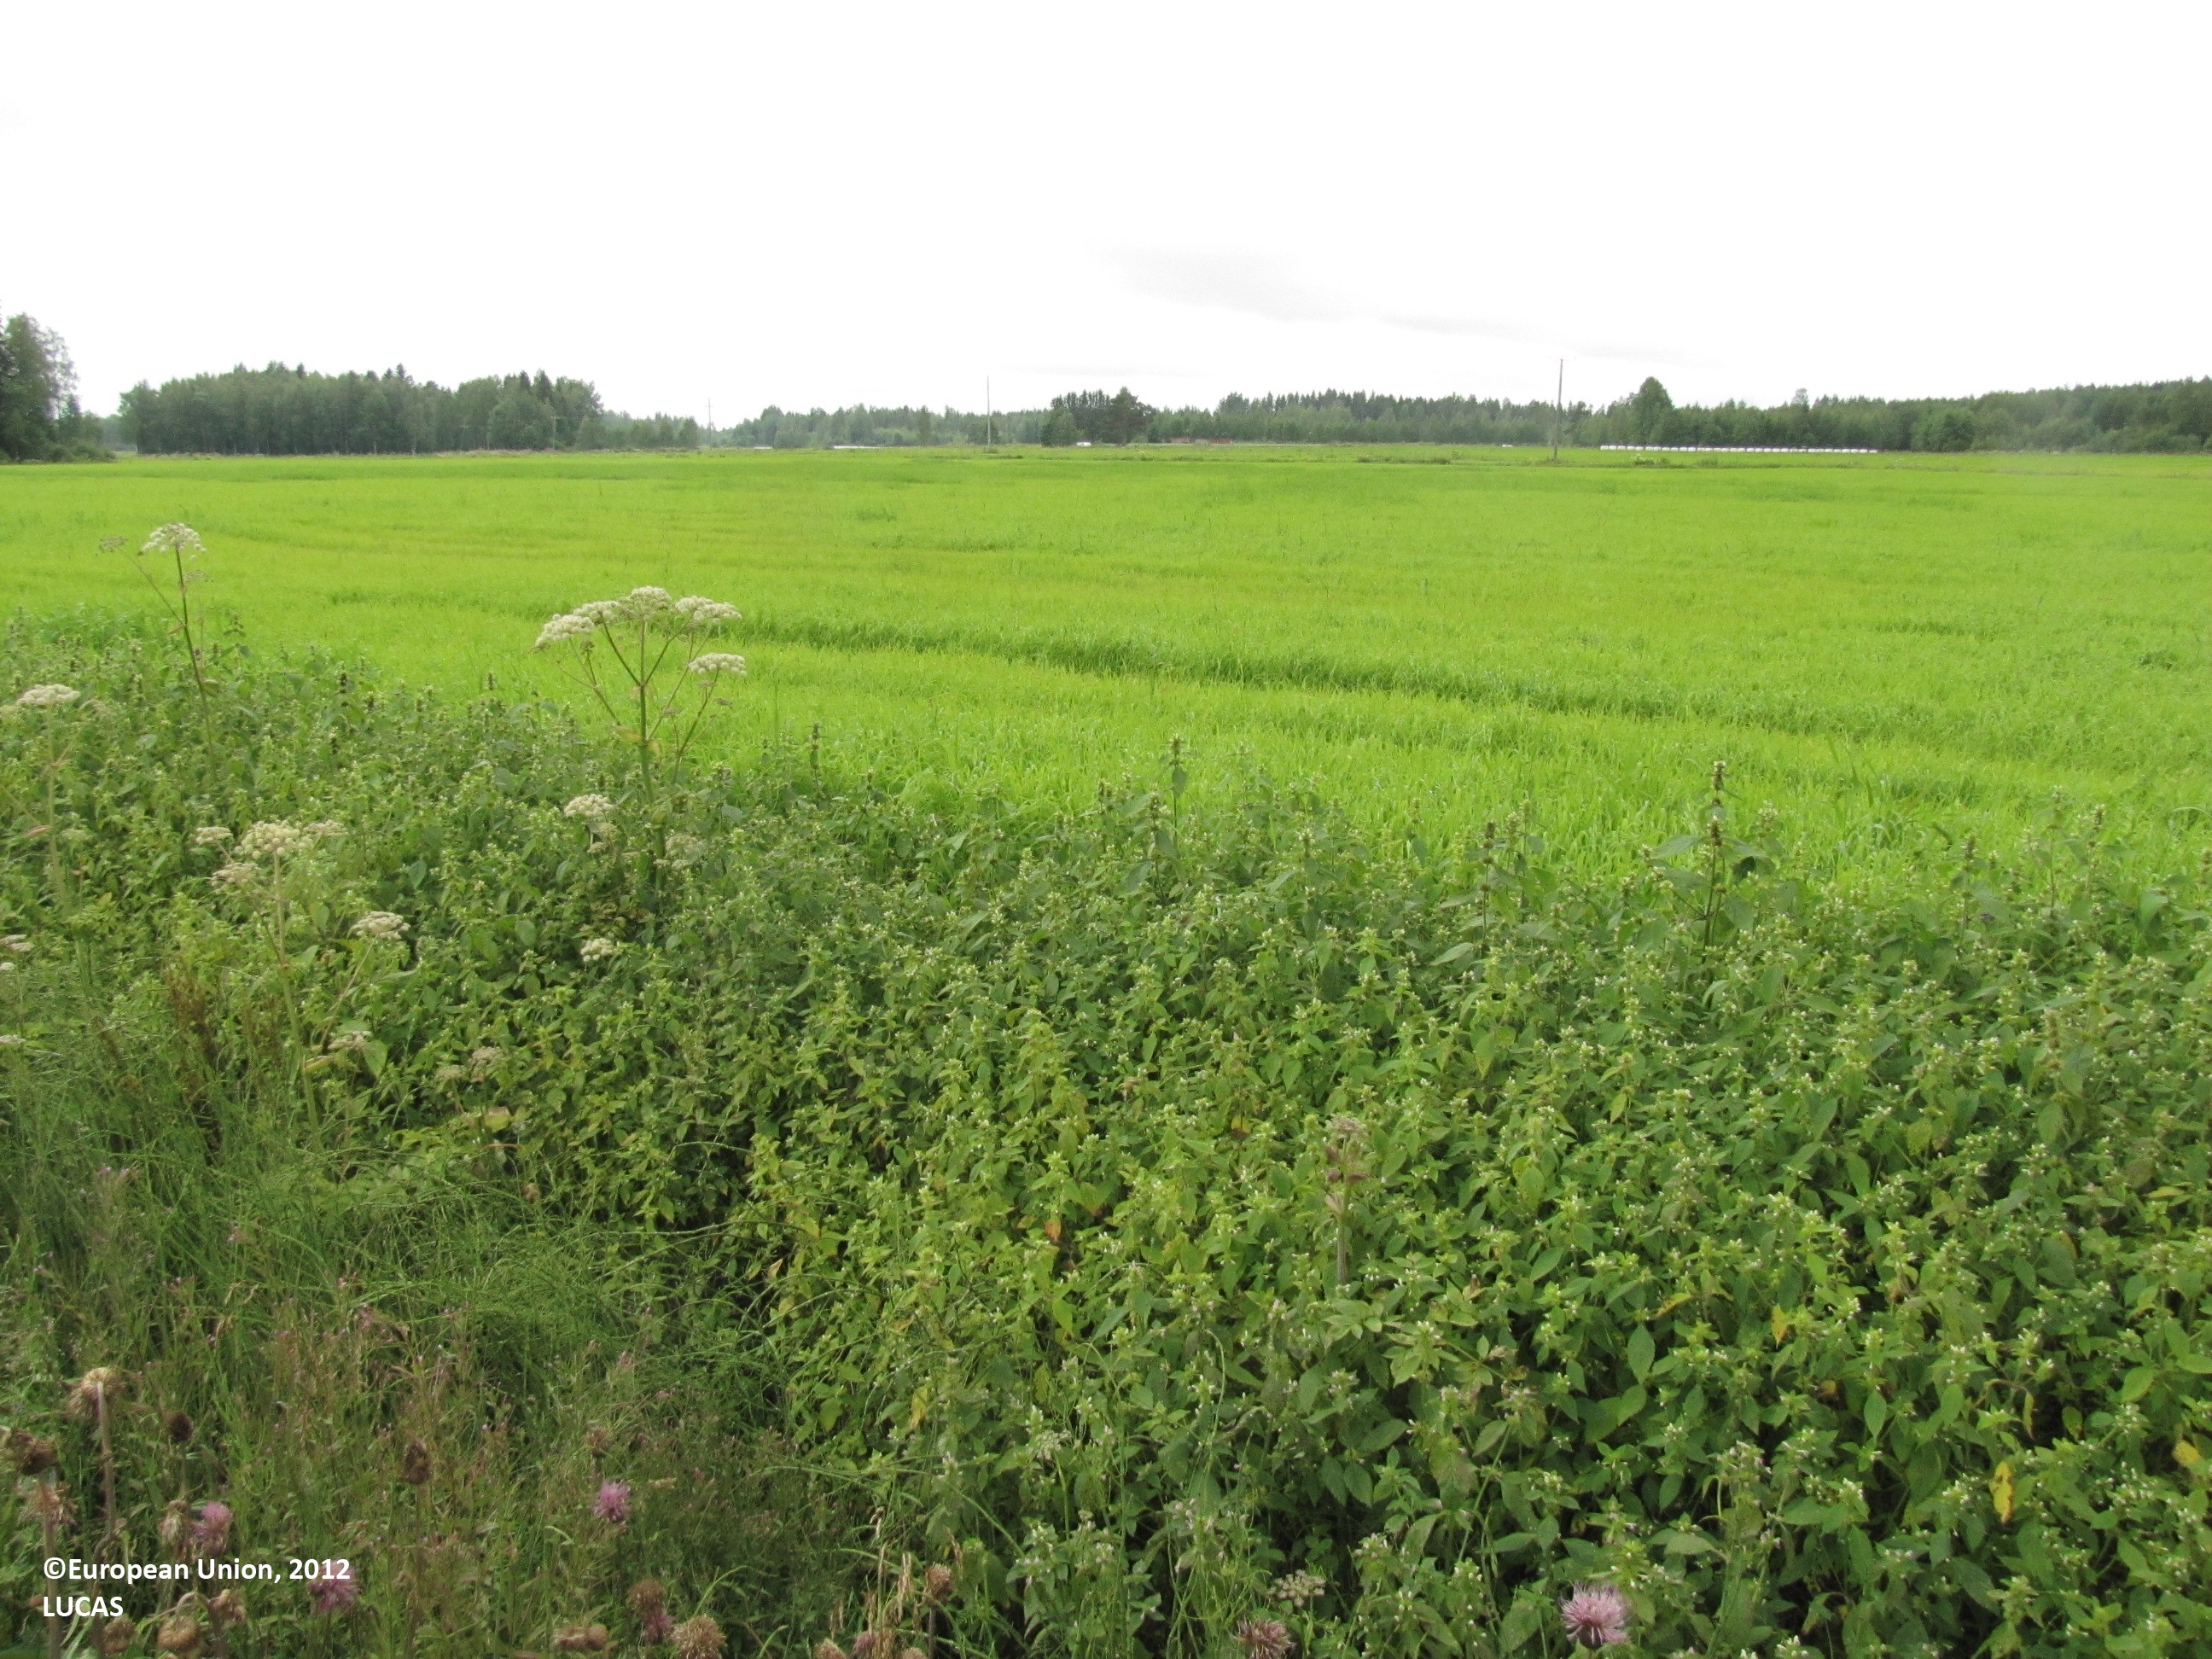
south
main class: Cropland
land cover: Oats
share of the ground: > 75 %
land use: Agriculture (excluding fallow land and kitchen gardens)
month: July
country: FI
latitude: 62.1926
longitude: 22.9973
